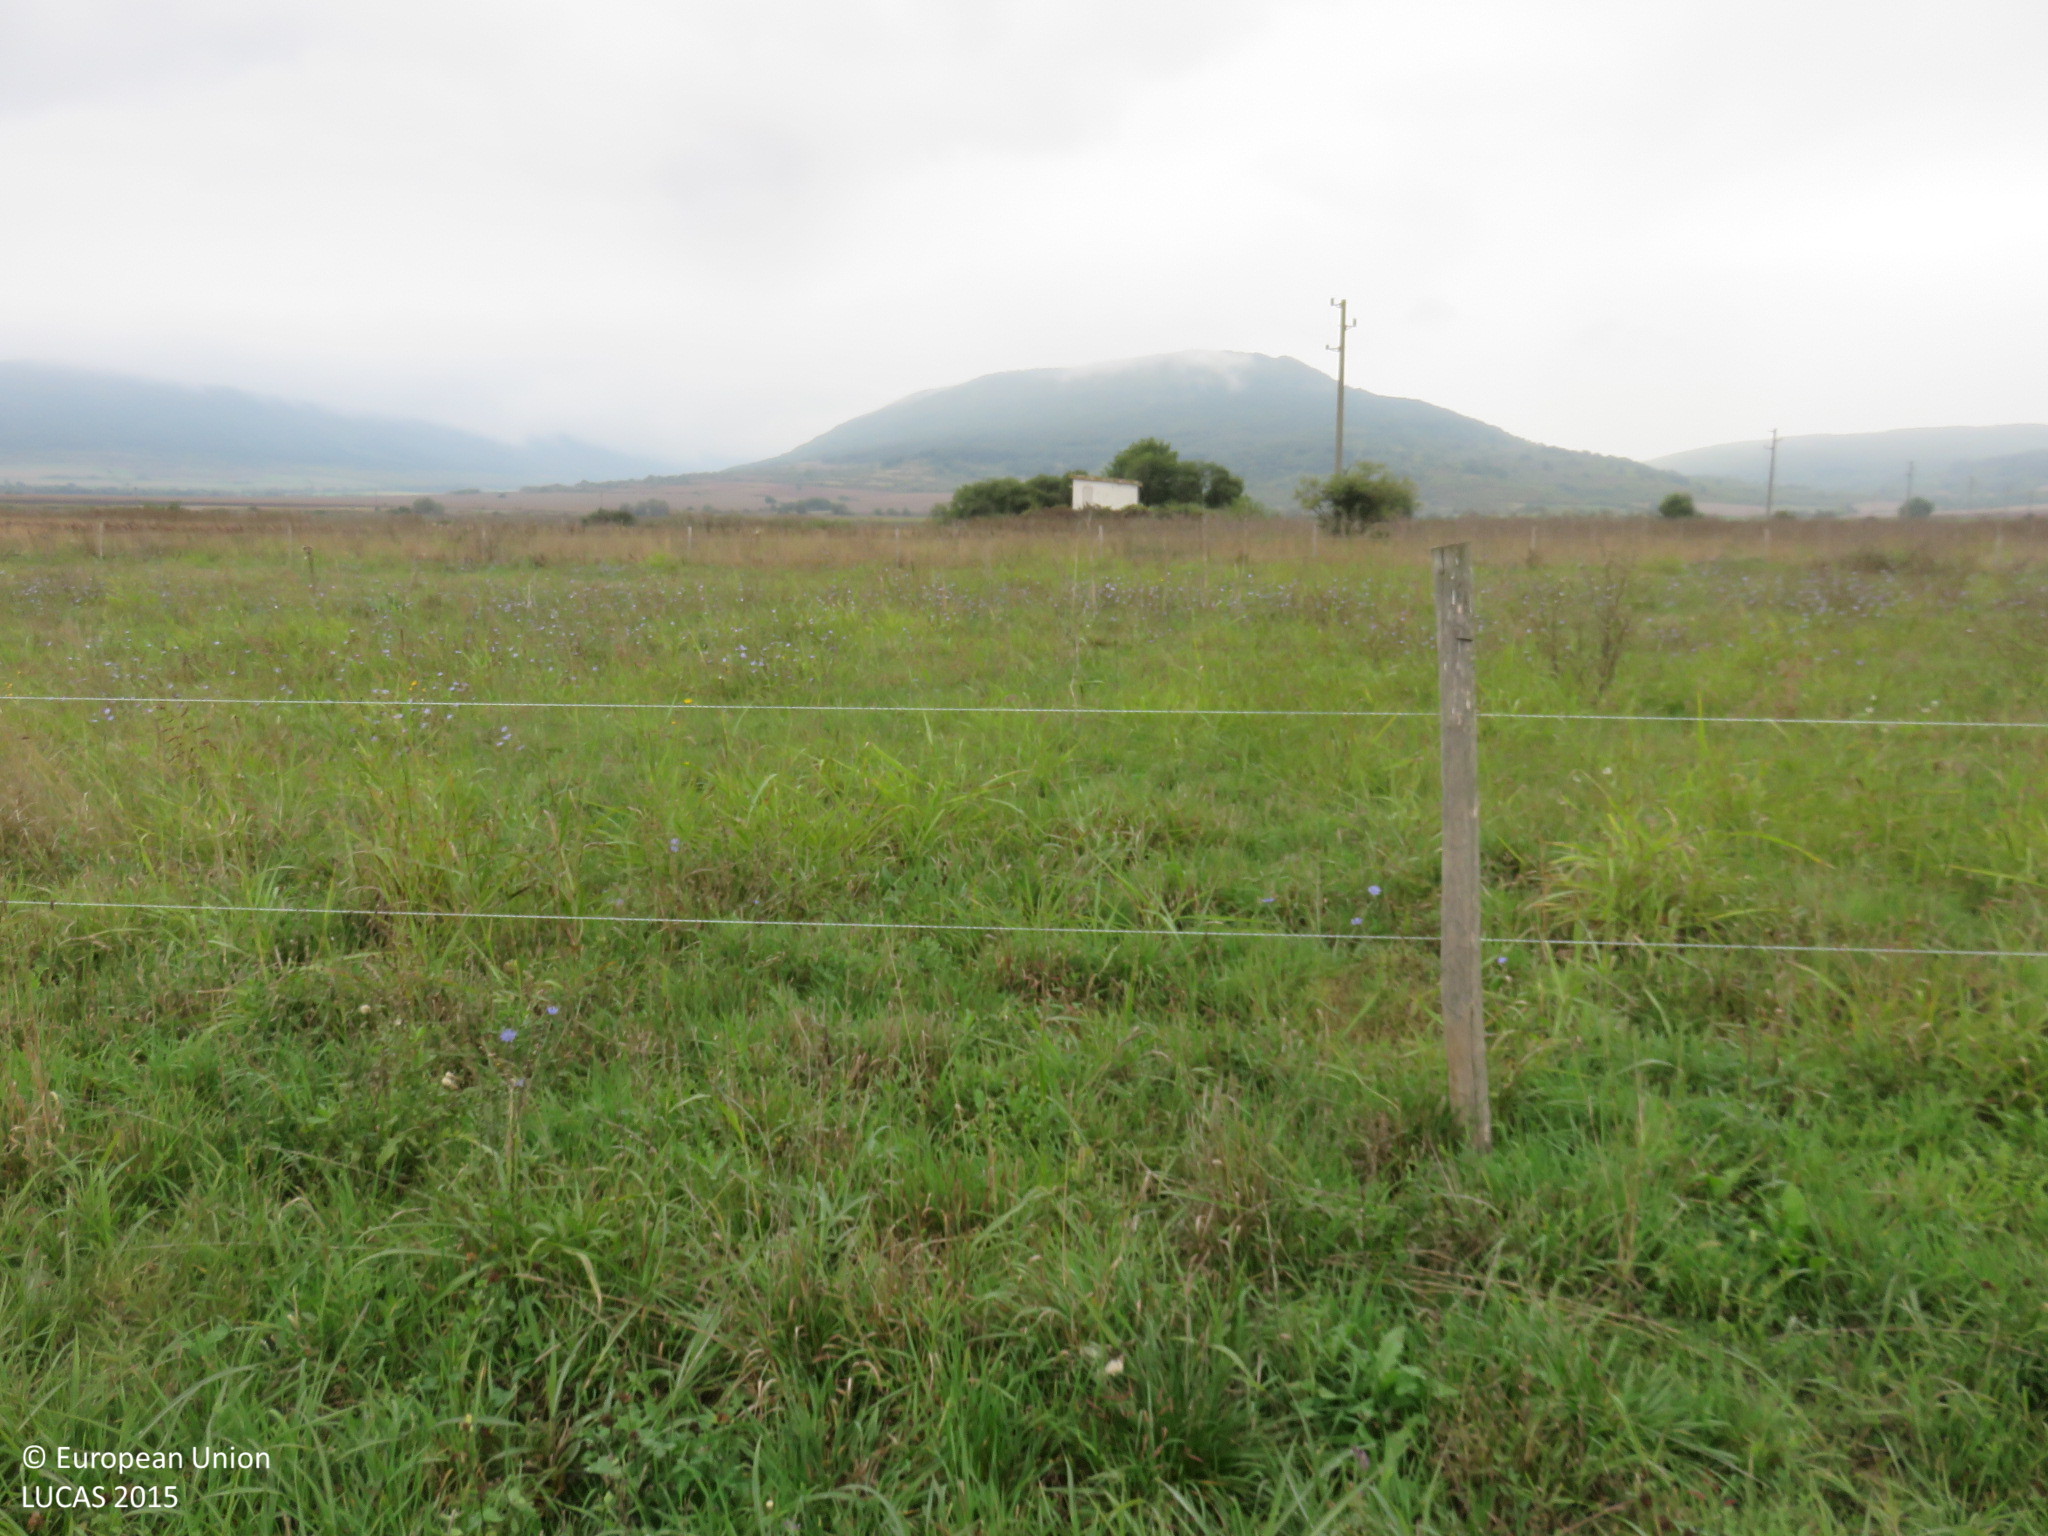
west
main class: Grassland
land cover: Grassland without tree/shrub cover
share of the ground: > 75 %
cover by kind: herbaceous plants 100 %
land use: Agriculture (excluding fallow land and kitchen gardens)
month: September
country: BG
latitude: 43.0466
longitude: 25.0314
